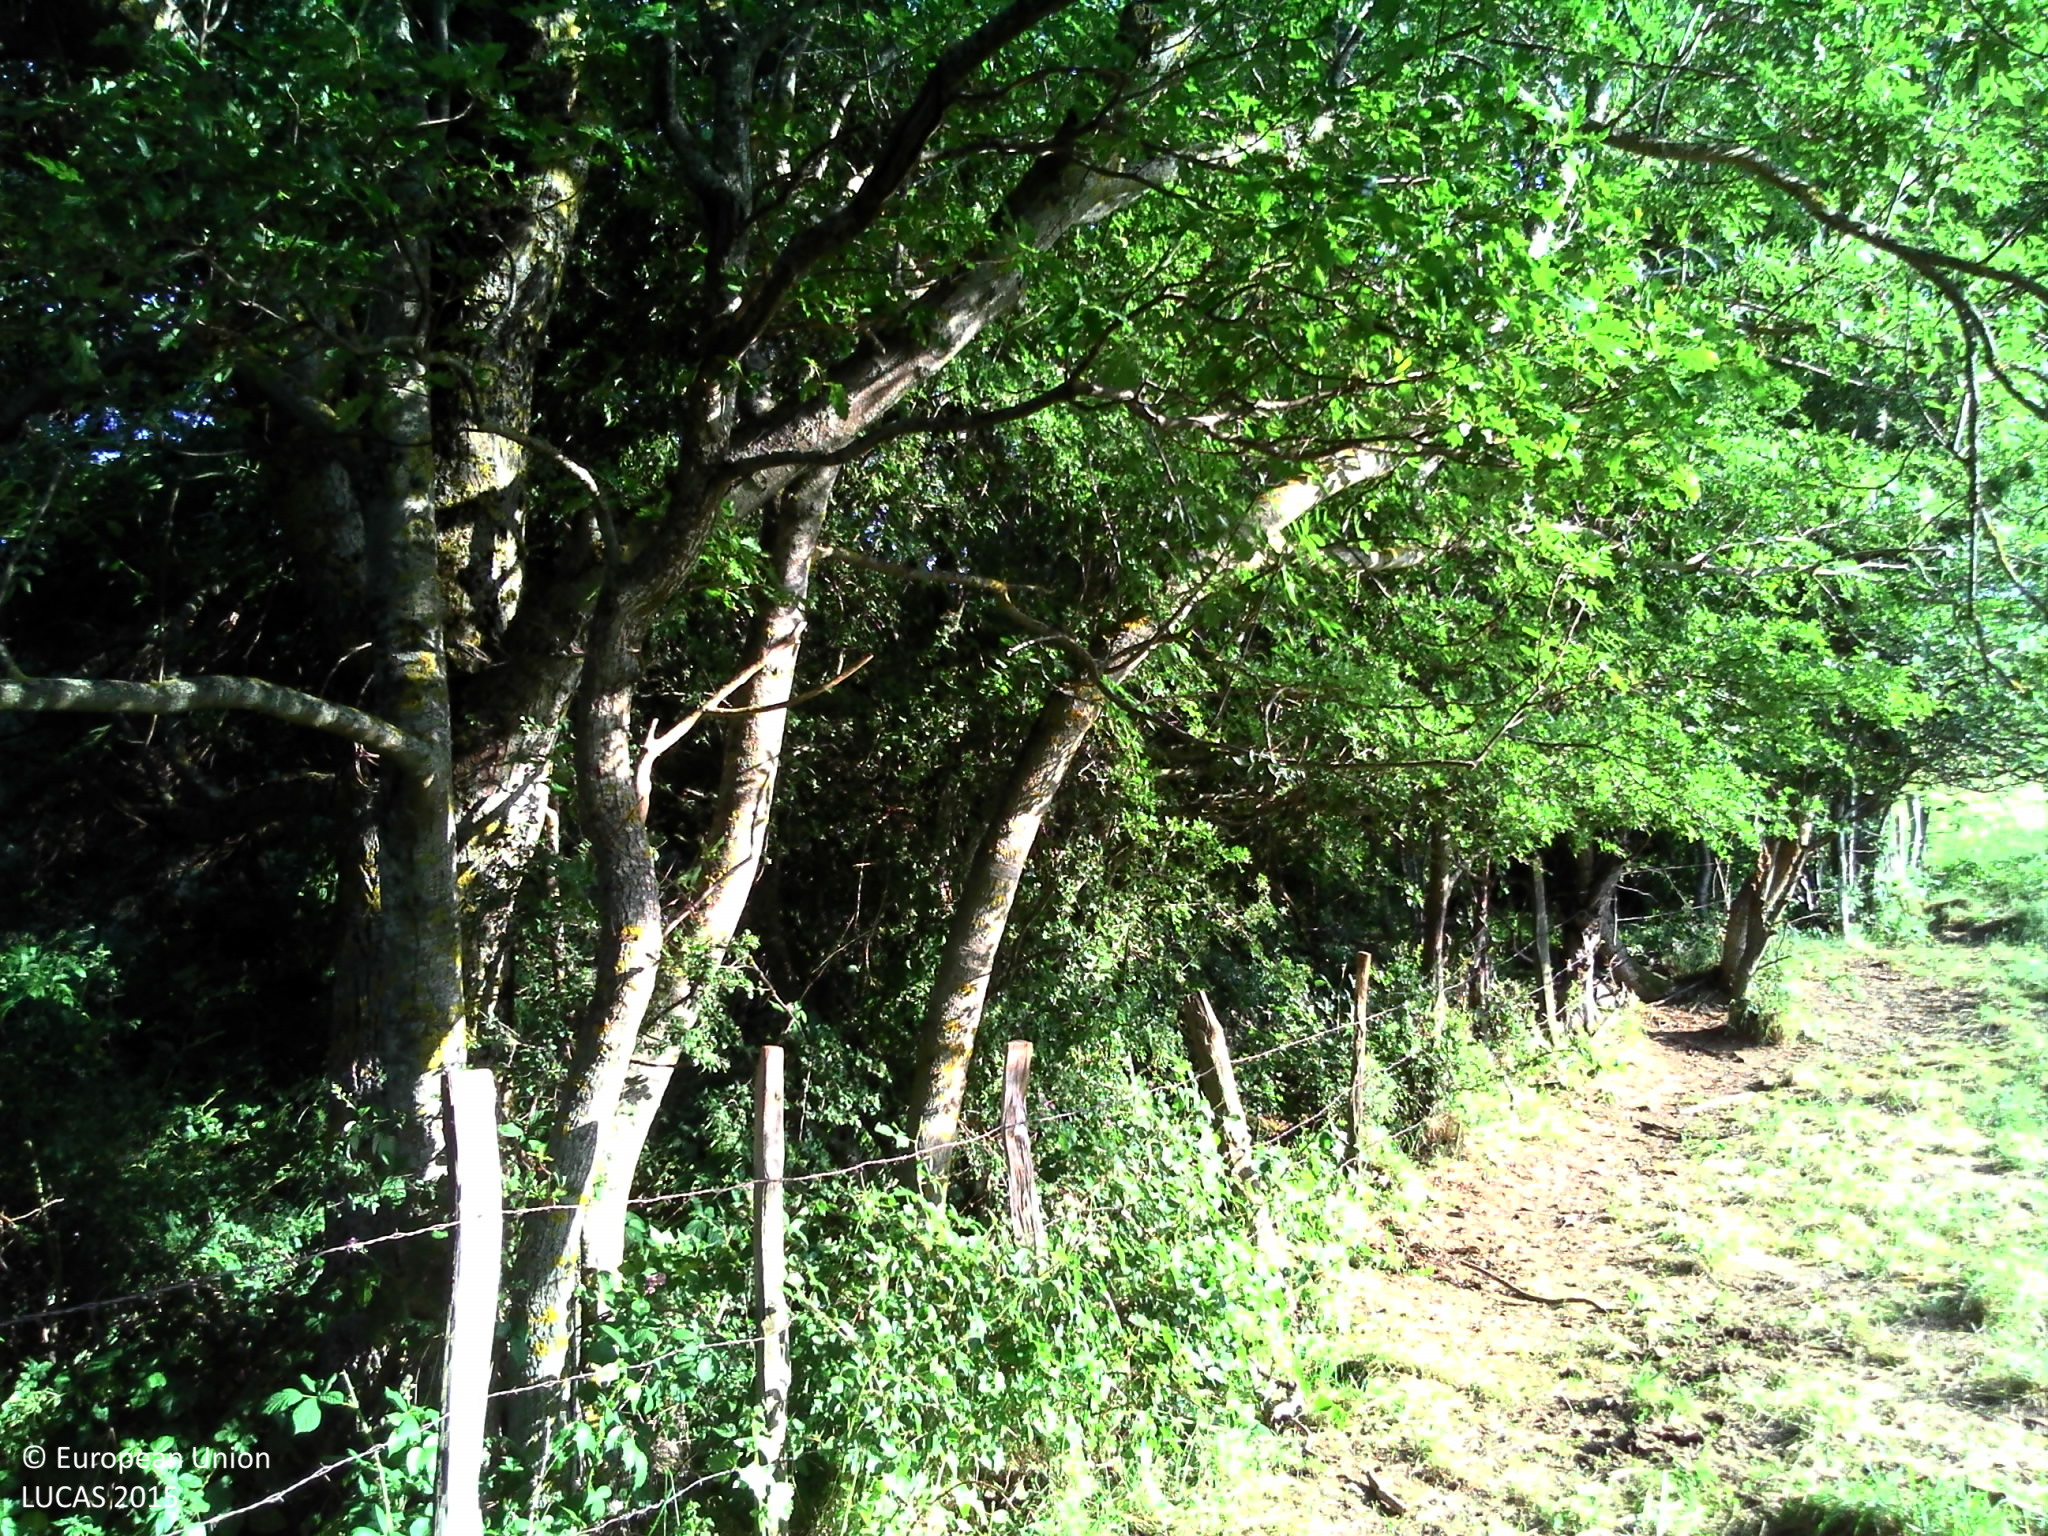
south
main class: Woodland
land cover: Broadleaved woodland
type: mesophytic deciduous forest
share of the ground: > 75 %
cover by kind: broadleaved forest trees 90 %, shrubs 5 %, herbaceous plants 5 %
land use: Forestry
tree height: > 5 m
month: July
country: FR
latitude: 45.4778
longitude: 3.1055
